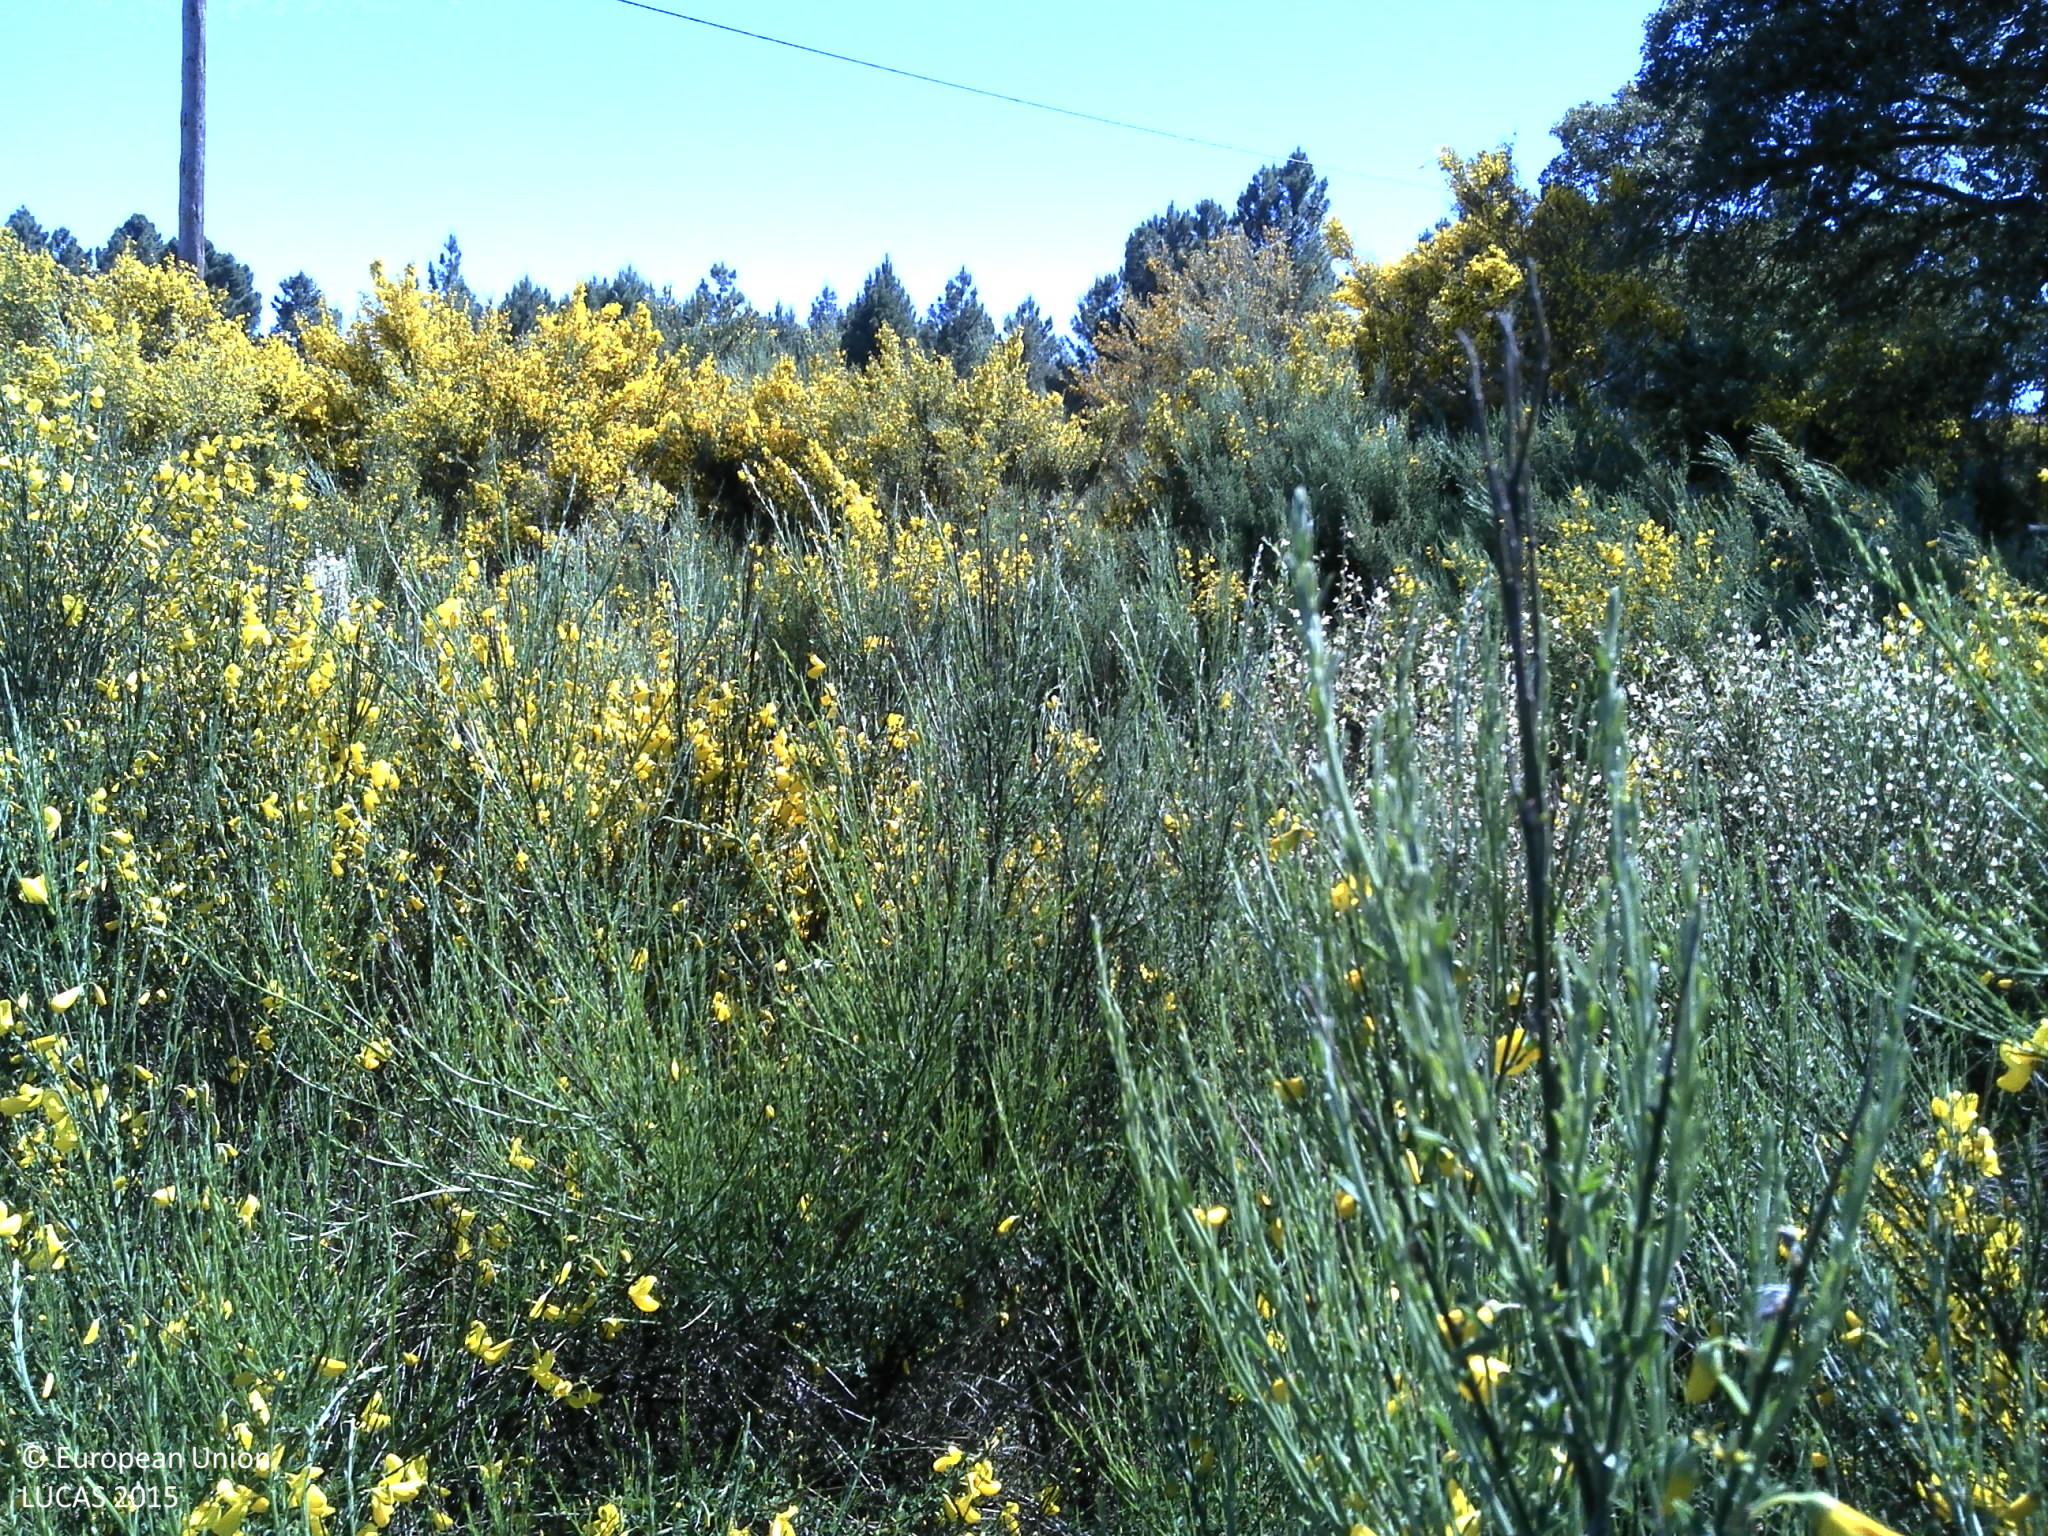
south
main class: Shrubland
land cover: Shrubland without tree cover
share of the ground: 50 - 75 %
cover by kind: shrubs 65 %, herbaceous plants 20 %, unconsolidated bare surface 15 %
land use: Forestry
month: May
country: PT
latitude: 41.8021
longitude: -7.3756
